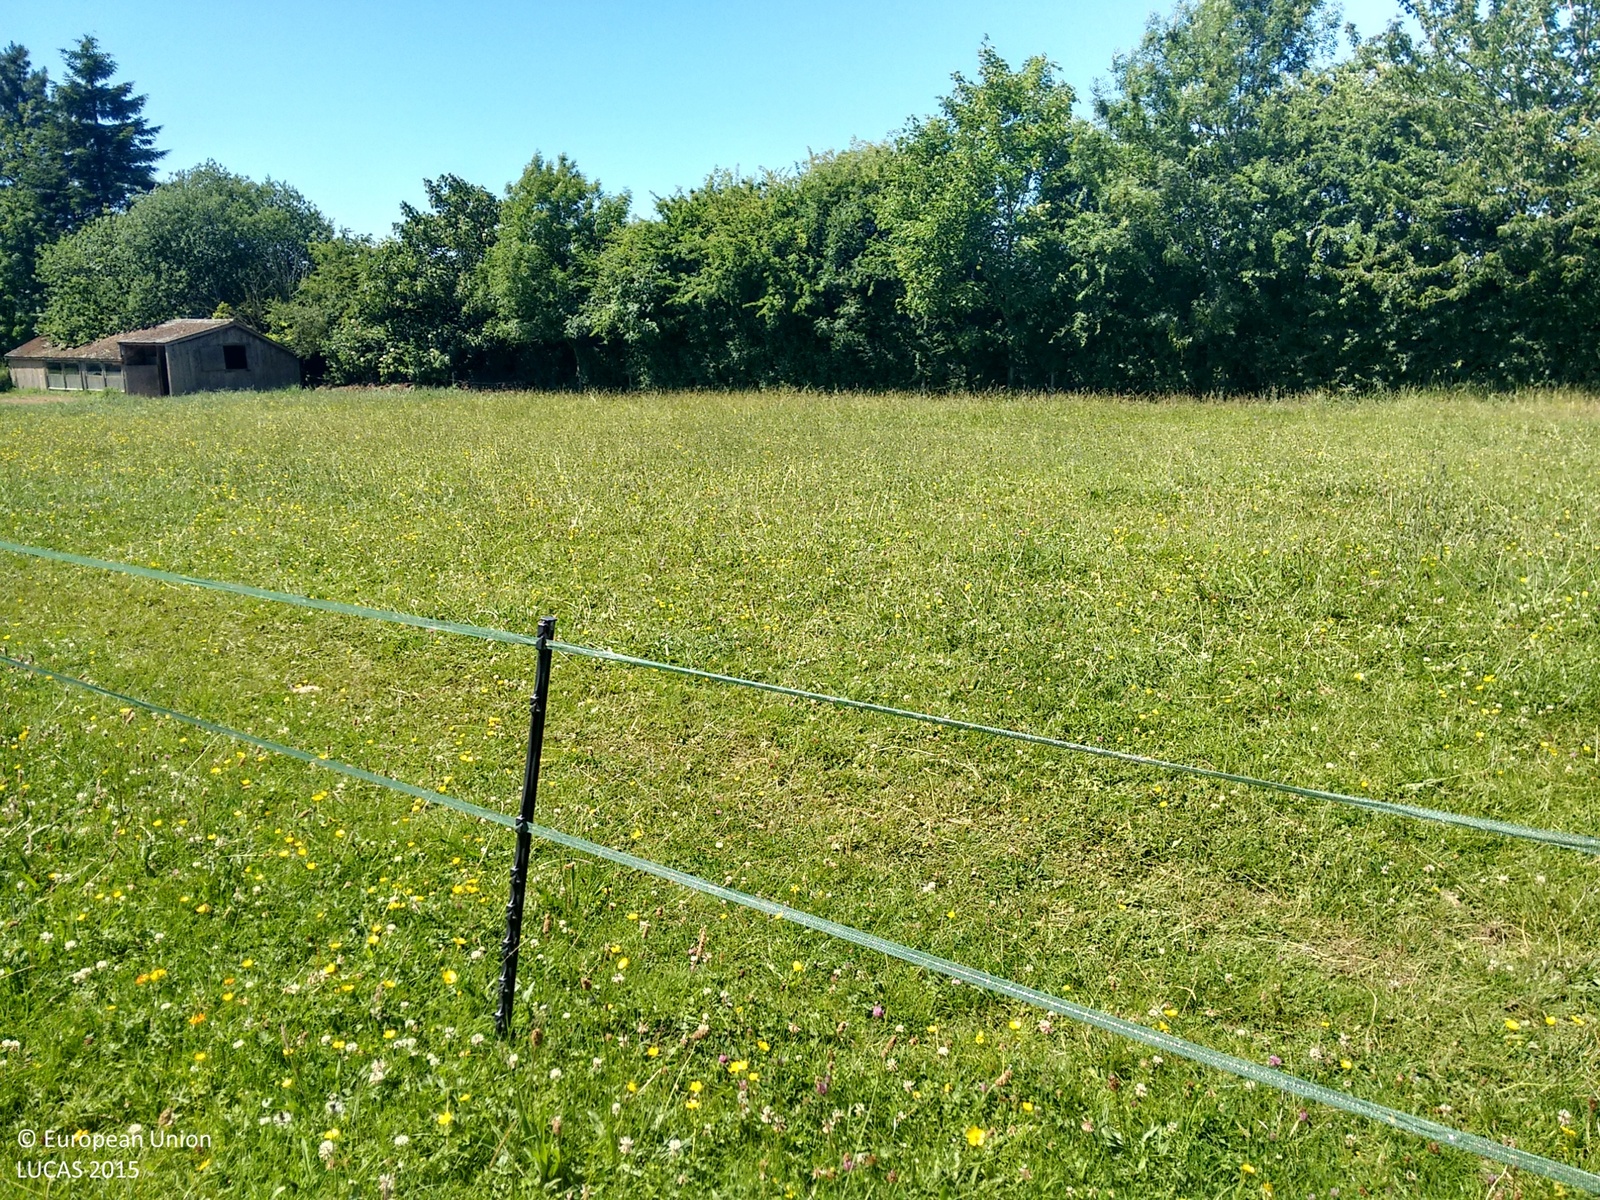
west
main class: Grassland
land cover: Grassland without tree/shrub cover
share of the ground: > 75 %
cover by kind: herbaceous plants 100 %
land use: Agriculture (excluding fallow land and kitchen gardens)
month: June
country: GB
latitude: 52.0784
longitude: -2.6615
